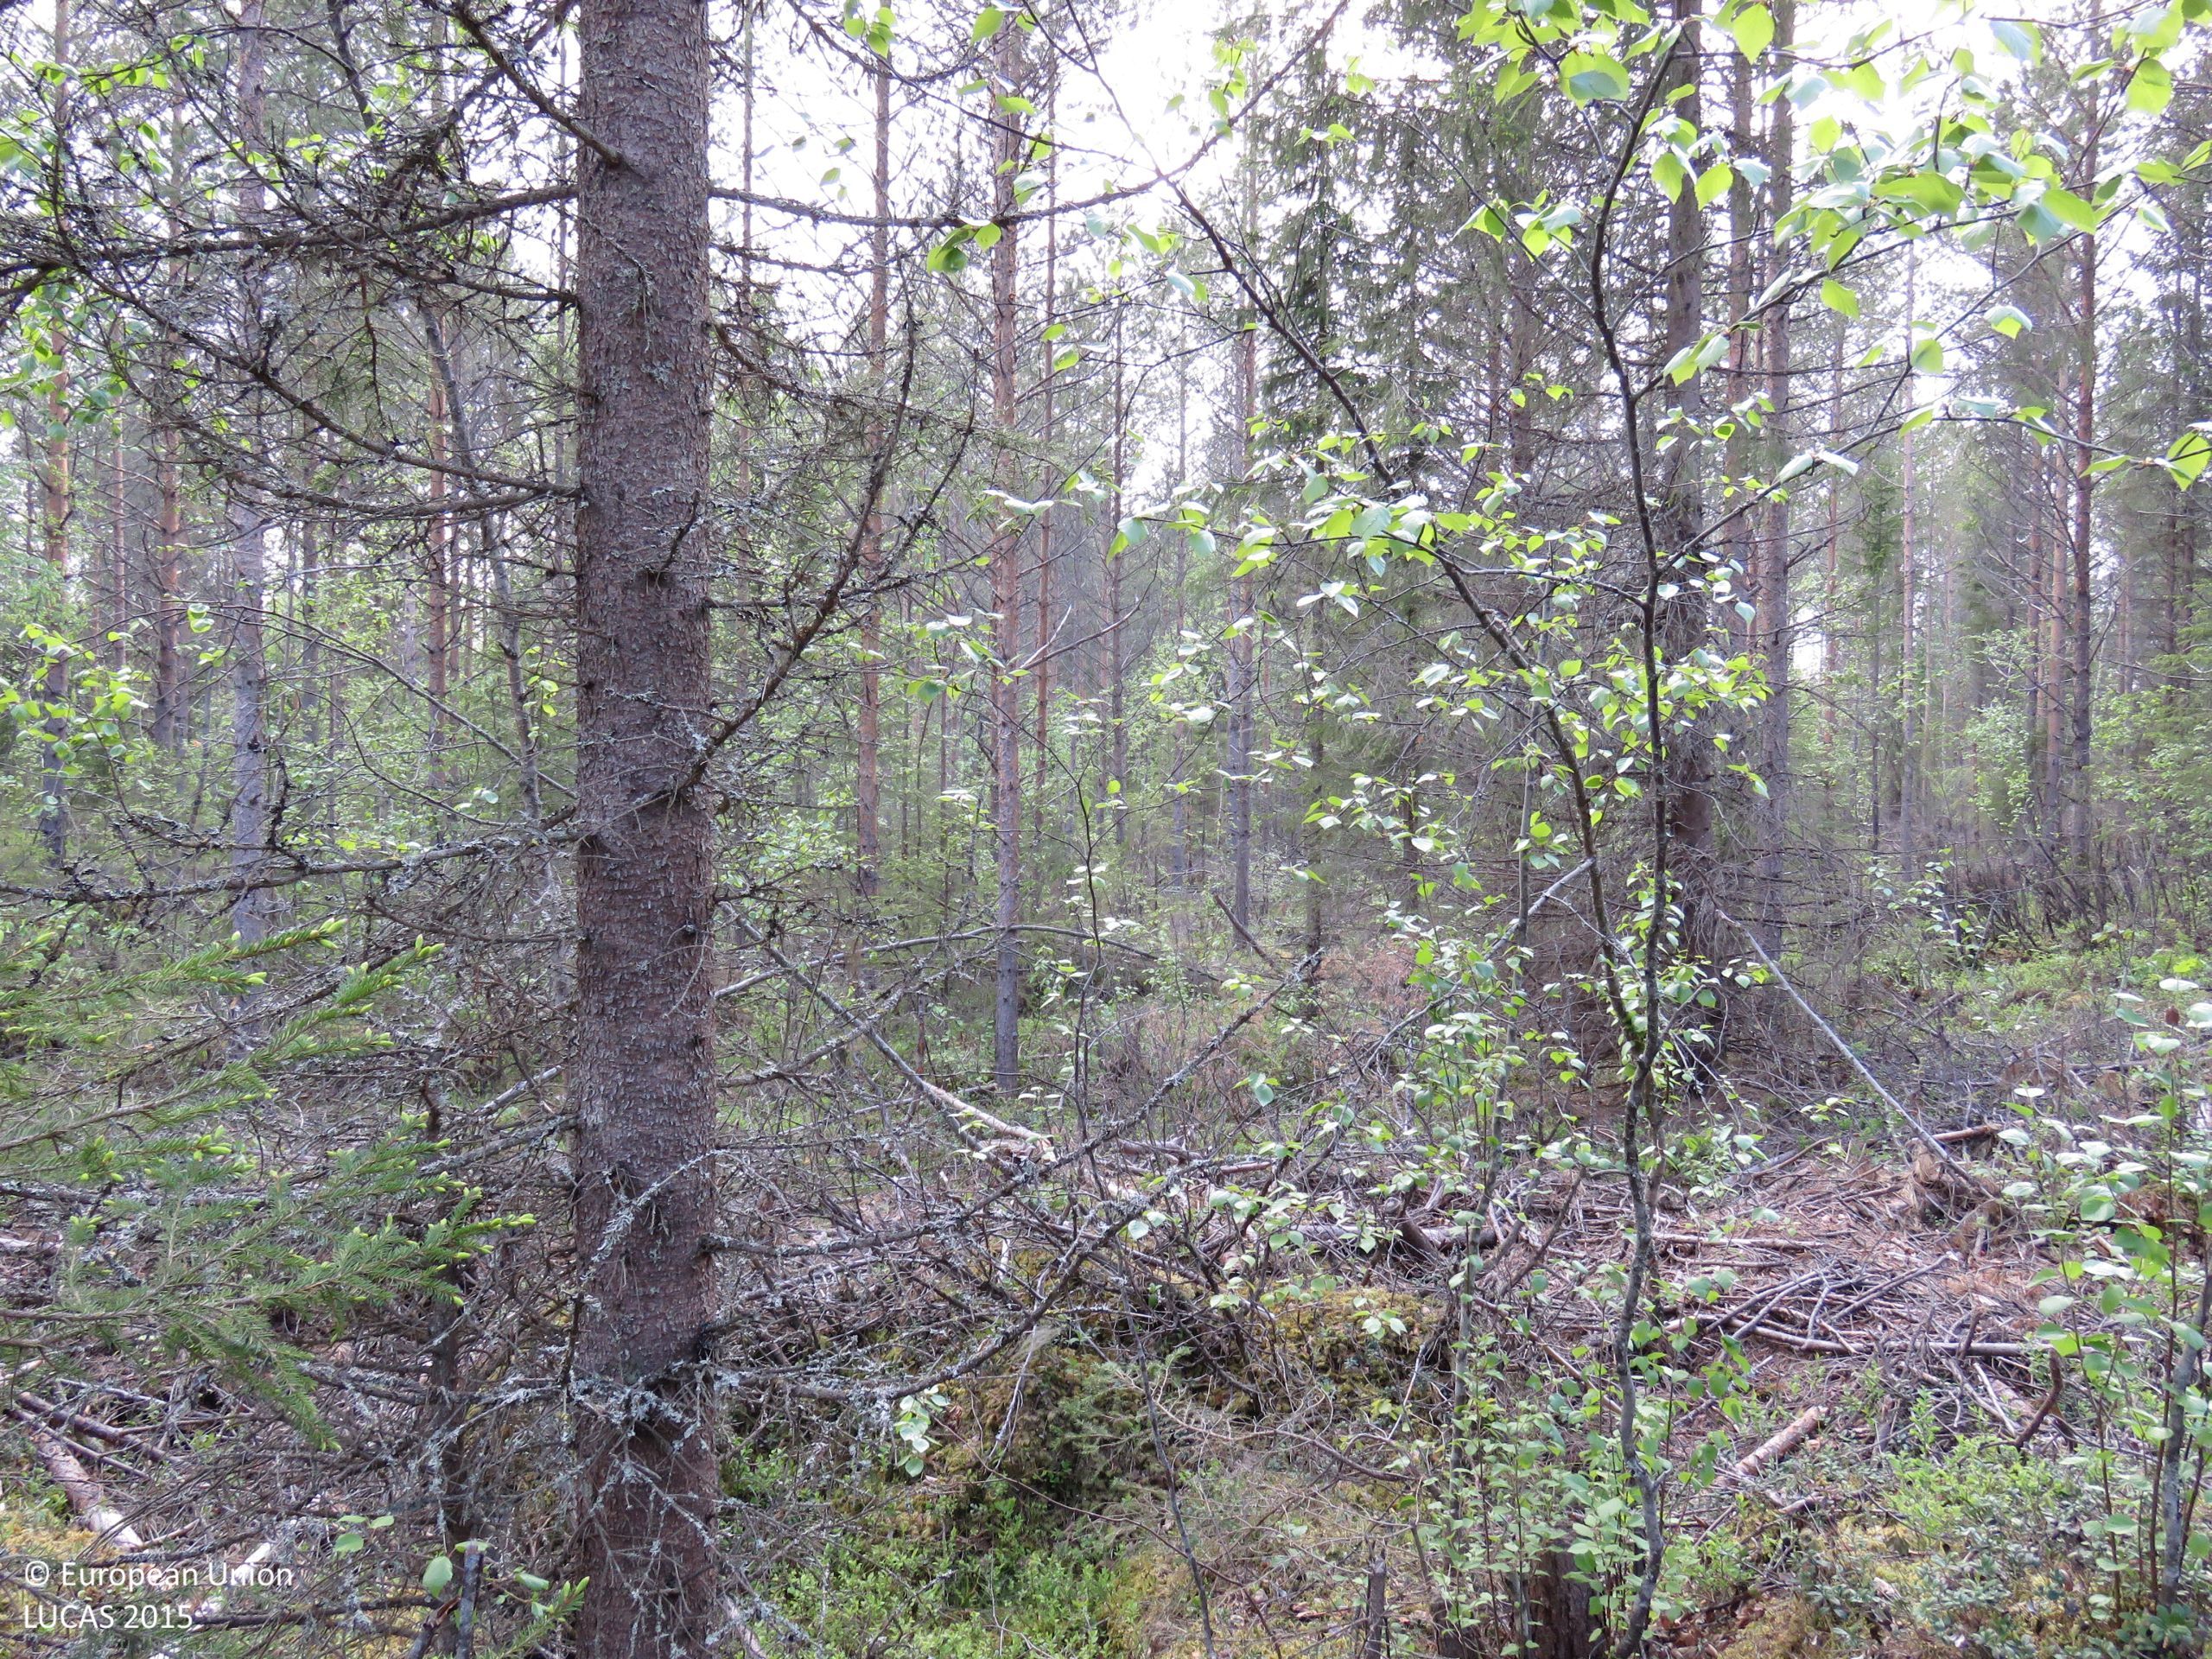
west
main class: Woodland
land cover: Other coniferous woodland
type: boreal forest
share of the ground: 50 - 75 %
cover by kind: coniferous forest trees 60 %, shrubs 30 %, broadleaved forest trees 5 %, lichens and mosses 5 %
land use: Forestry
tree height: > 5 m
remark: Clear cut
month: June
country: FI
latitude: 65.0524
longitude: 25.7053
